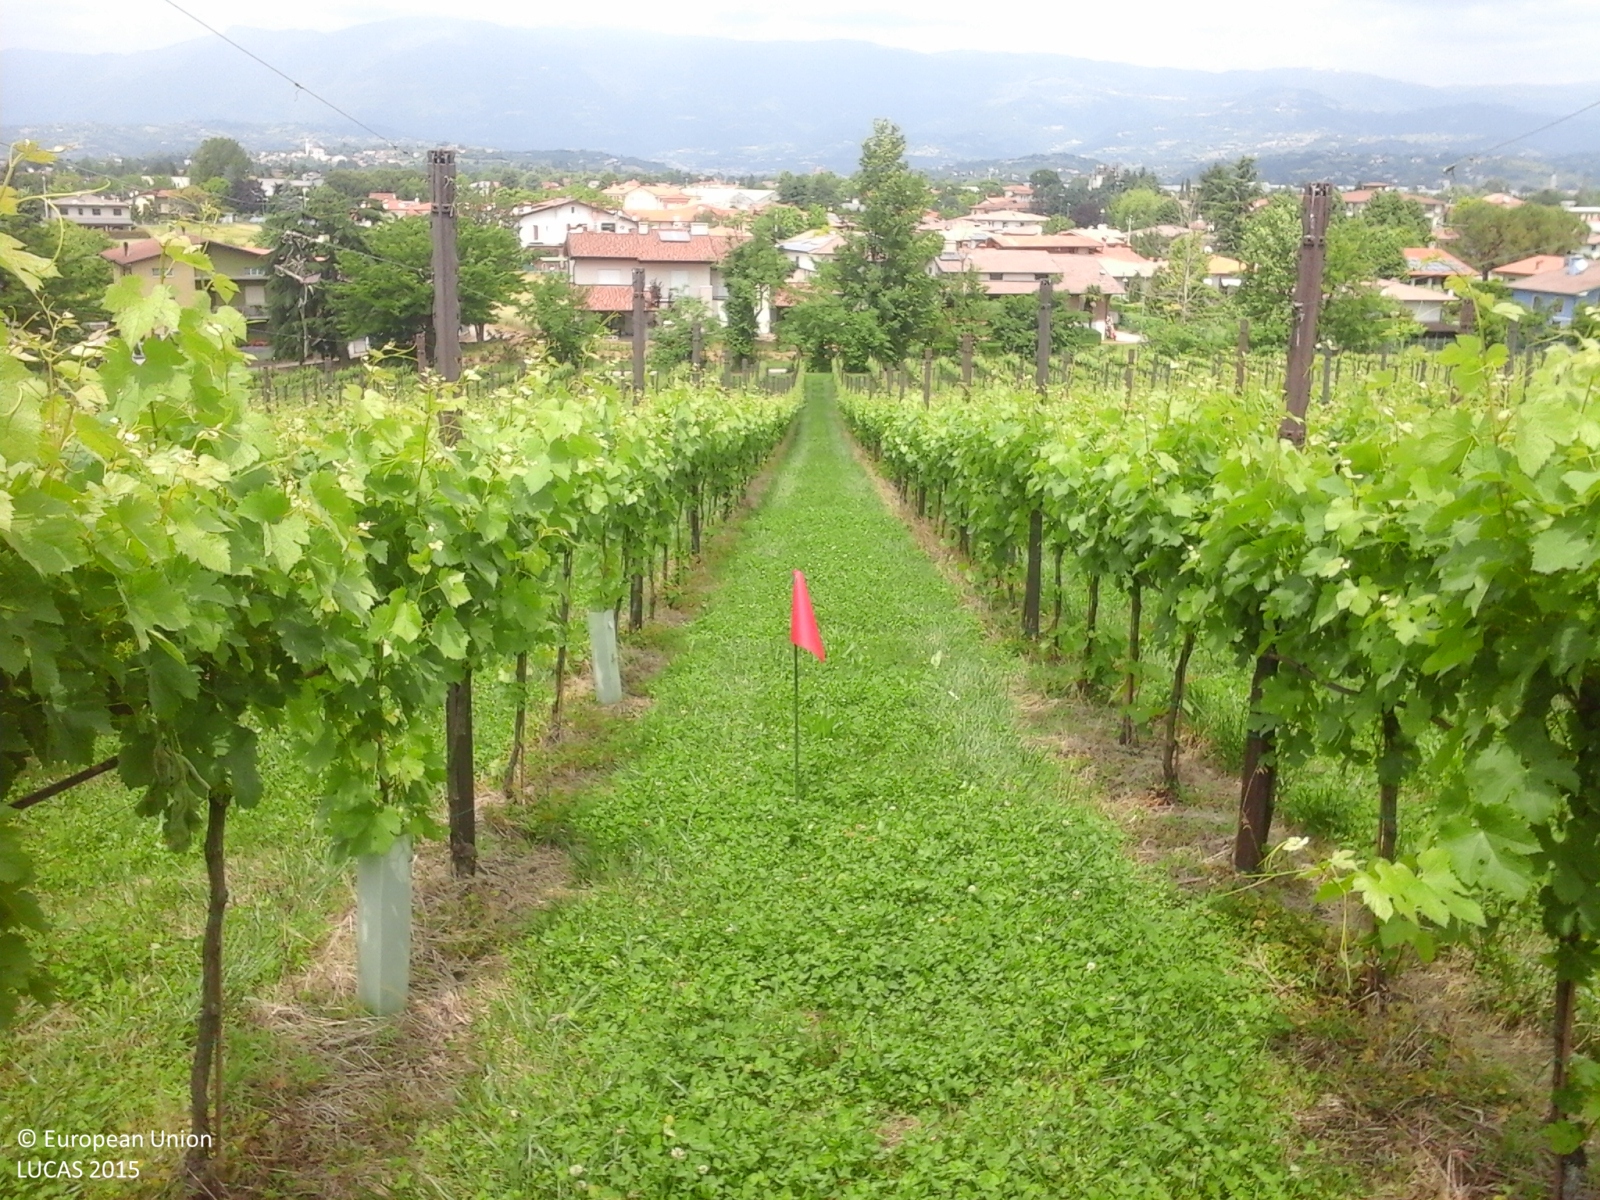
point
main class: Cropland
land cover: Vineyards
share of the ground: 25 - 50 %
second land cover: Grassland without tree/shrub cover
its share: > 75 %
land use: Agriculture (excluding fallow land and kitchen gardens)
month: May
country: IT
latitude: 45.6733
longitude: 11.5509
